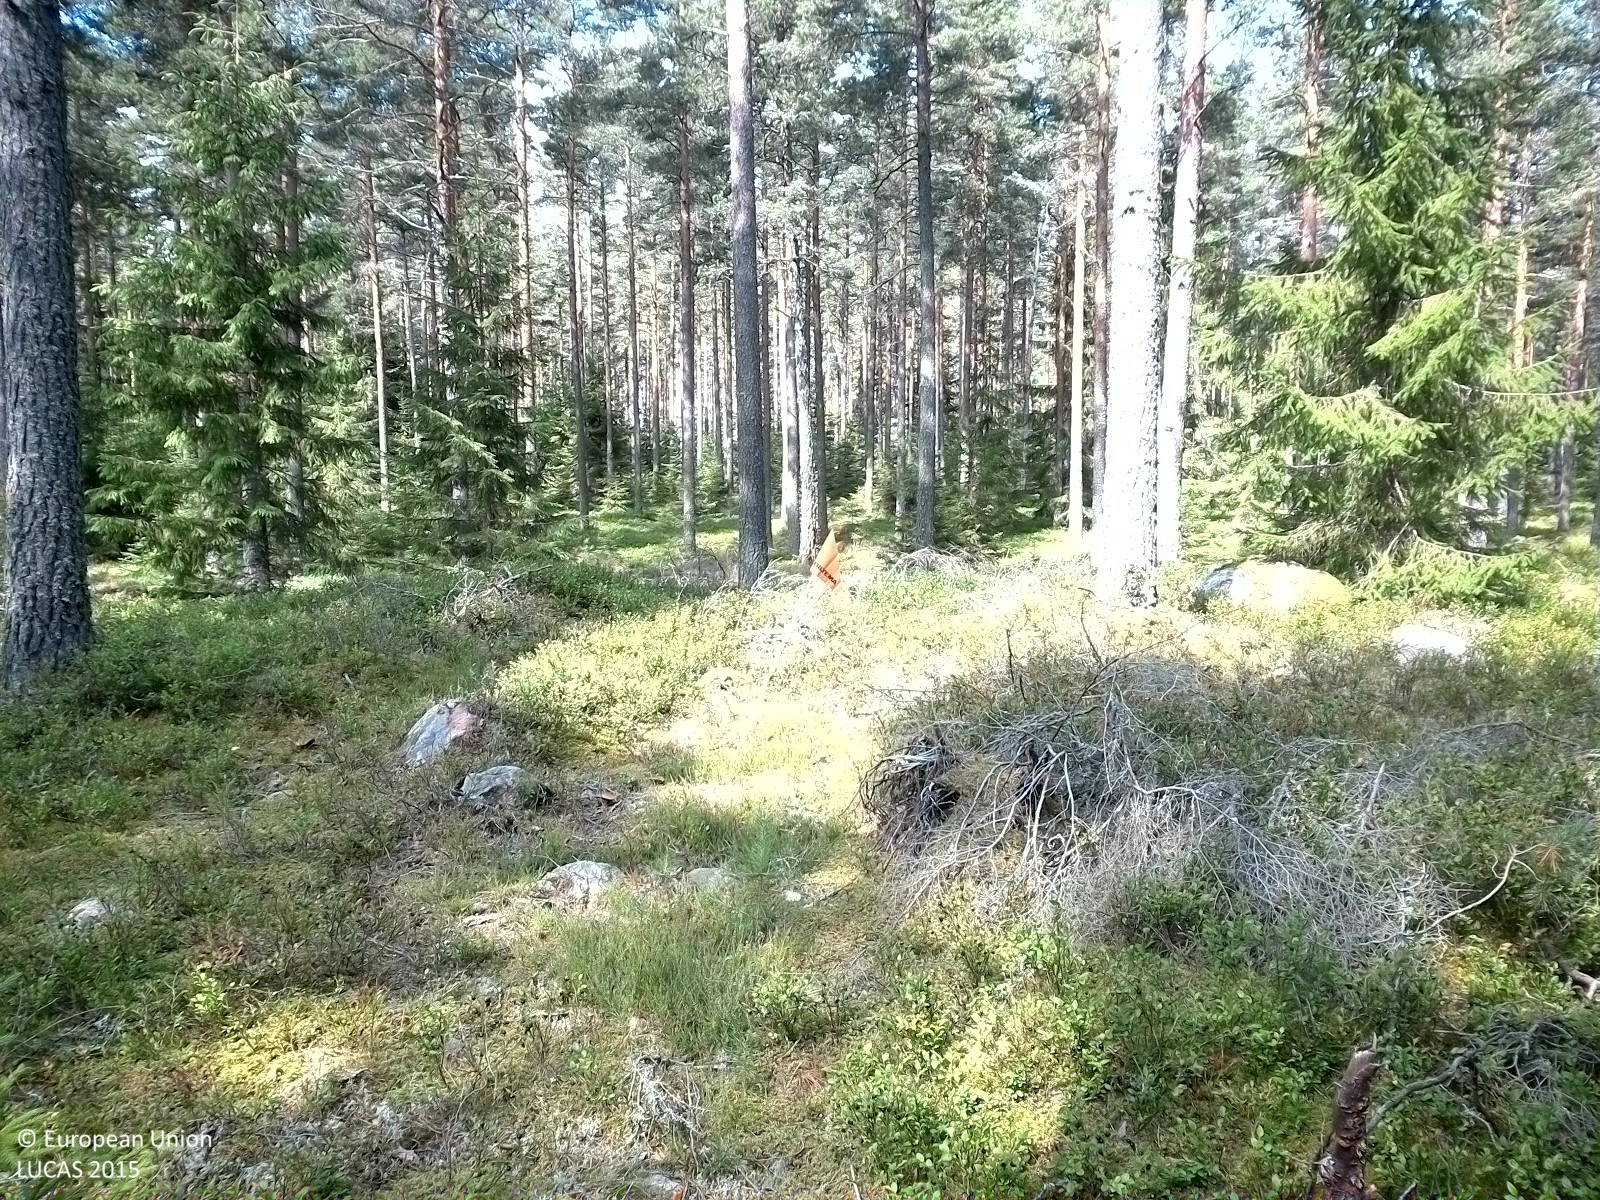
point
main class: Woodland
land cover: Pine dominated coniferous woodland
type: boreal forest
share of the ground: 25 - 50 %
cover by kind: herbaceous plants 40 %, coniferous forest trees 30 %, lichens and mosses 30 %
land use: Forestry
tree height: > 5 m
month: August
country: SE
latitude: 58.8856
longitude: 15.4235
